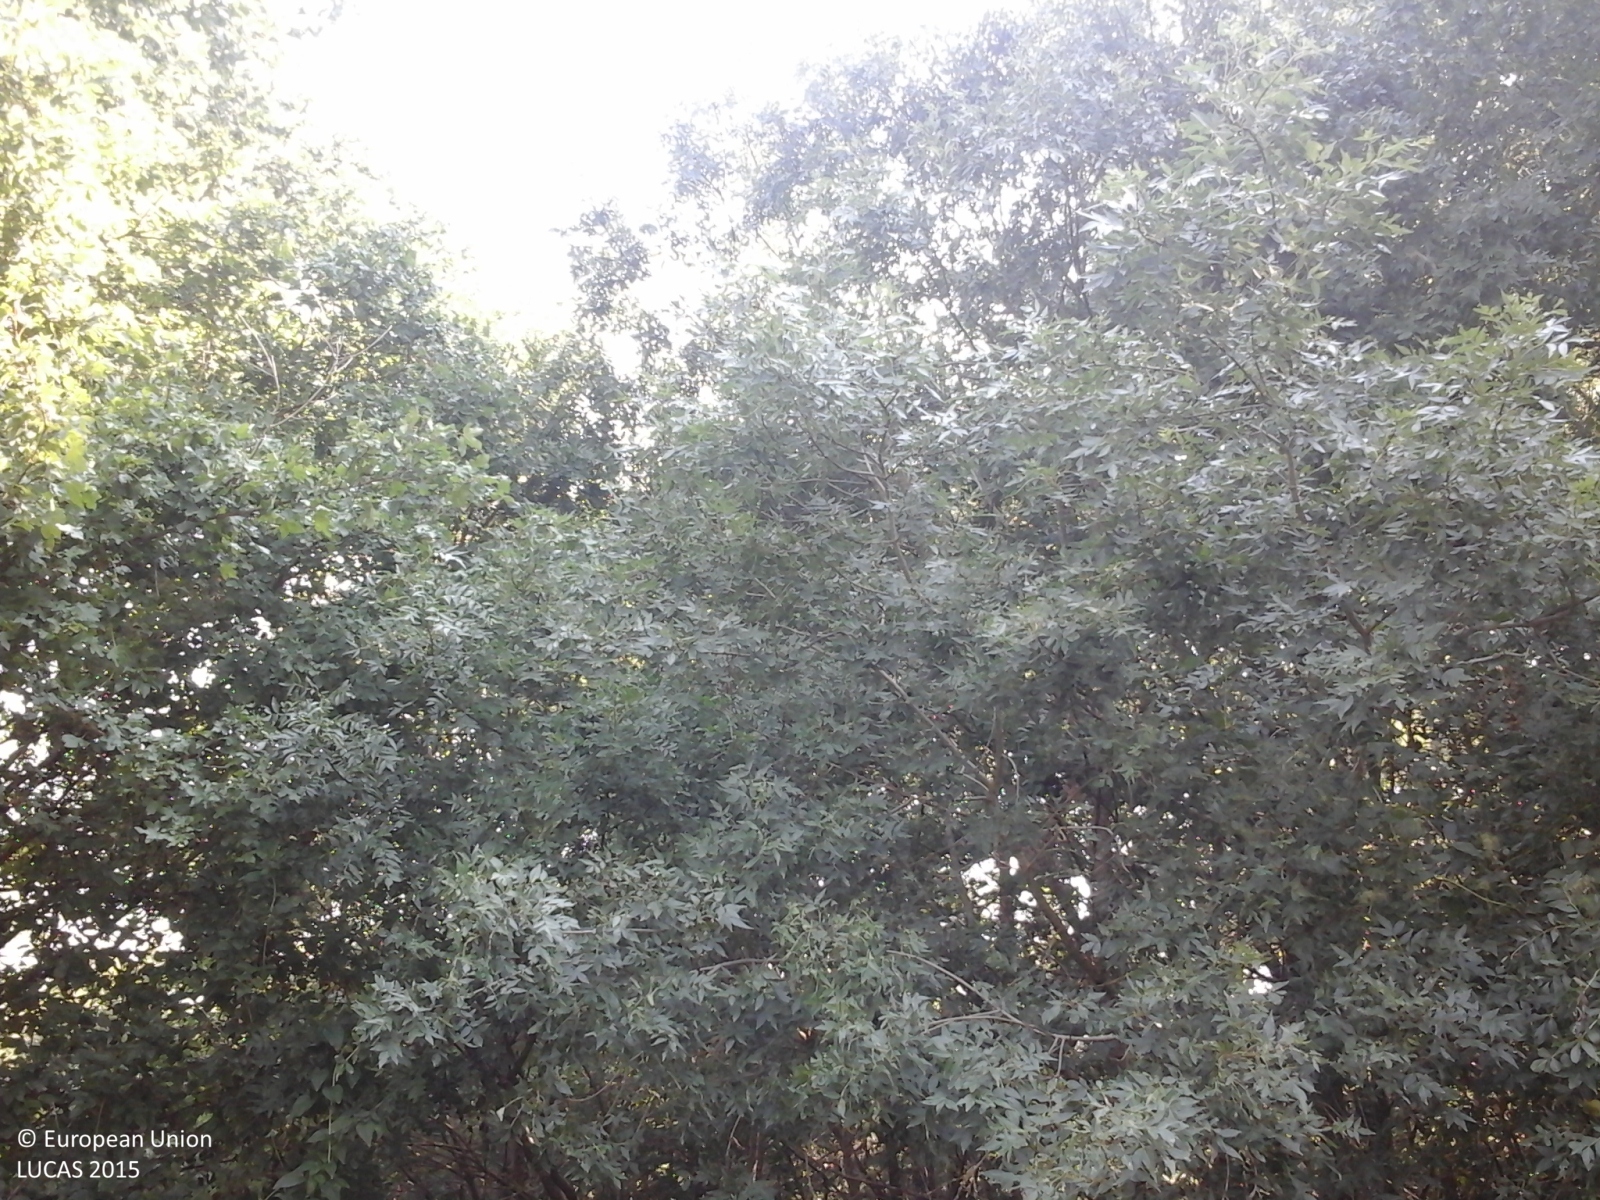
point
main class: Woodland
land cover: Broadleaved woodland
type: thermophilous deciduous forest
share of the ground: > 75 %
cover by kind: broadleaved forest trees 80 %, shrubs 15 %, herbaceous plants 5 %
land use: Forestry
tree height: > 5 m
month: August
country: IT
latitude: 41.3484
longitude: 15.1093
